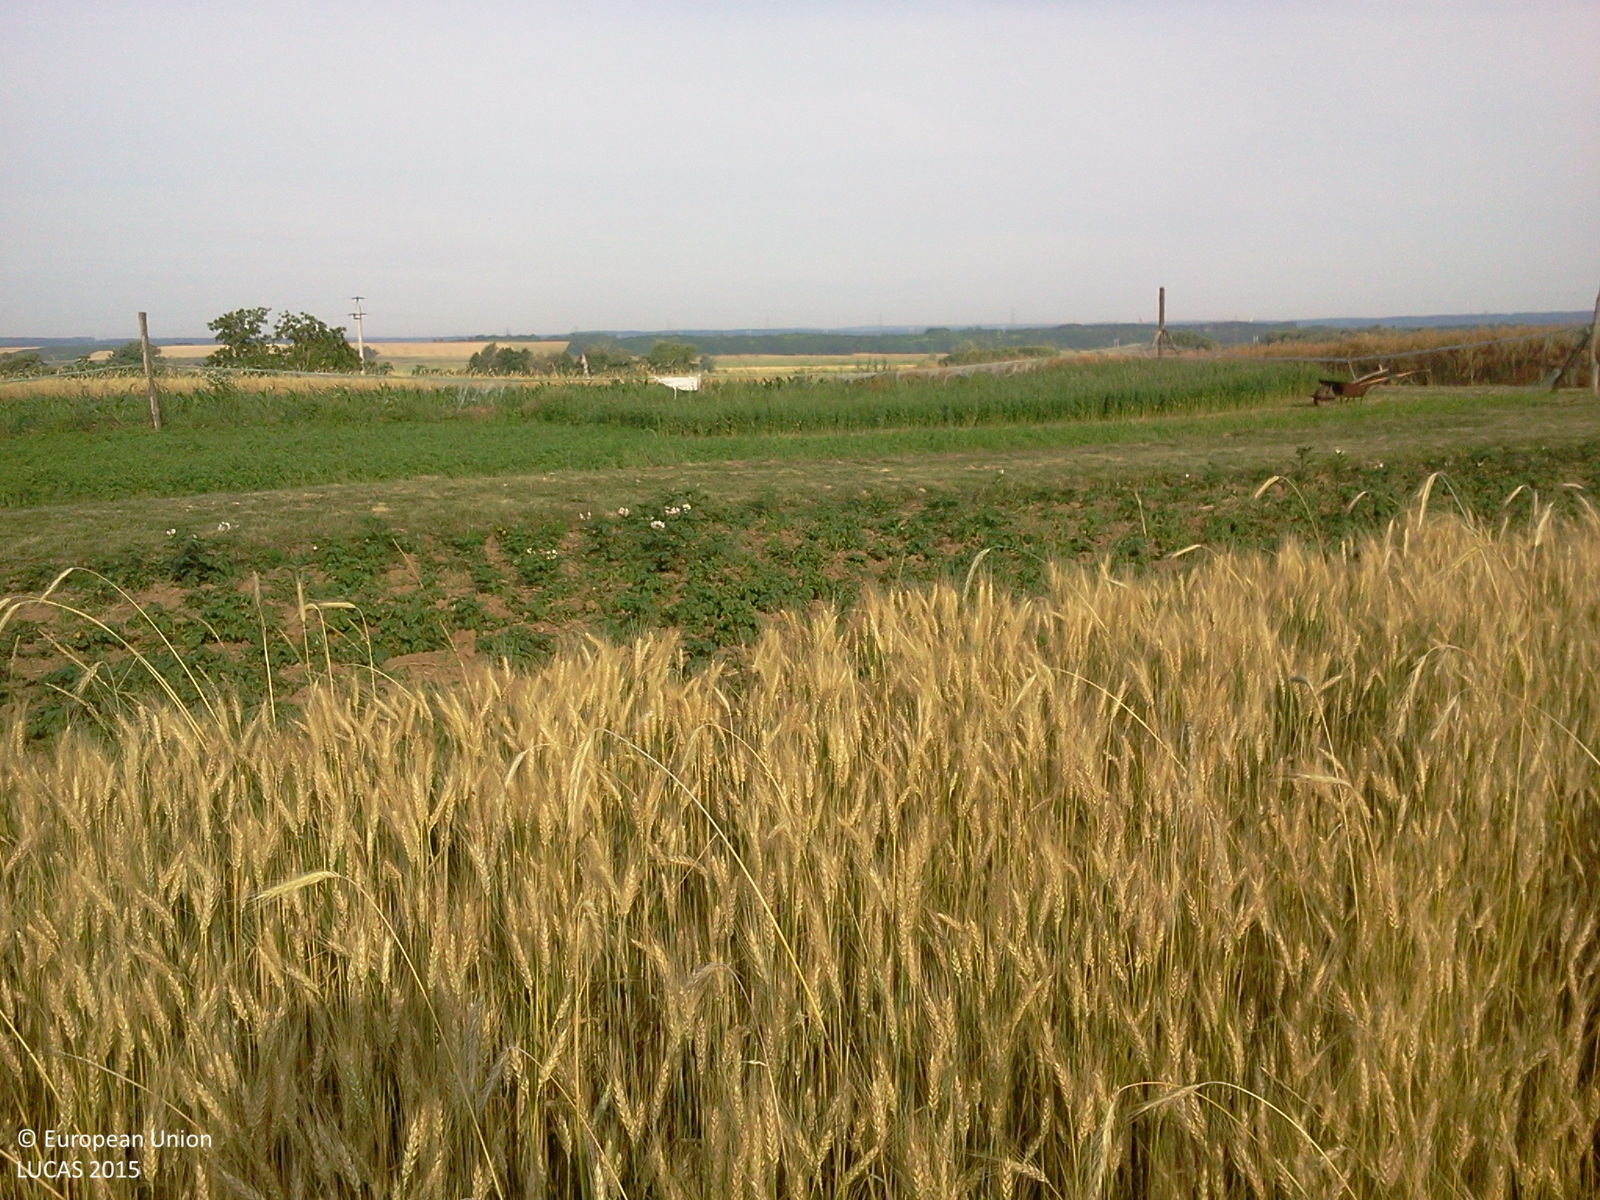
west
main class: Cropland
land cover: Durum wheat
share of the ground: > 75 %
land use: Agriculture (excluding fallow land and kitchen gardens)
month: June
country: HU
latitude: 46.7180
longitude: 17.0027
